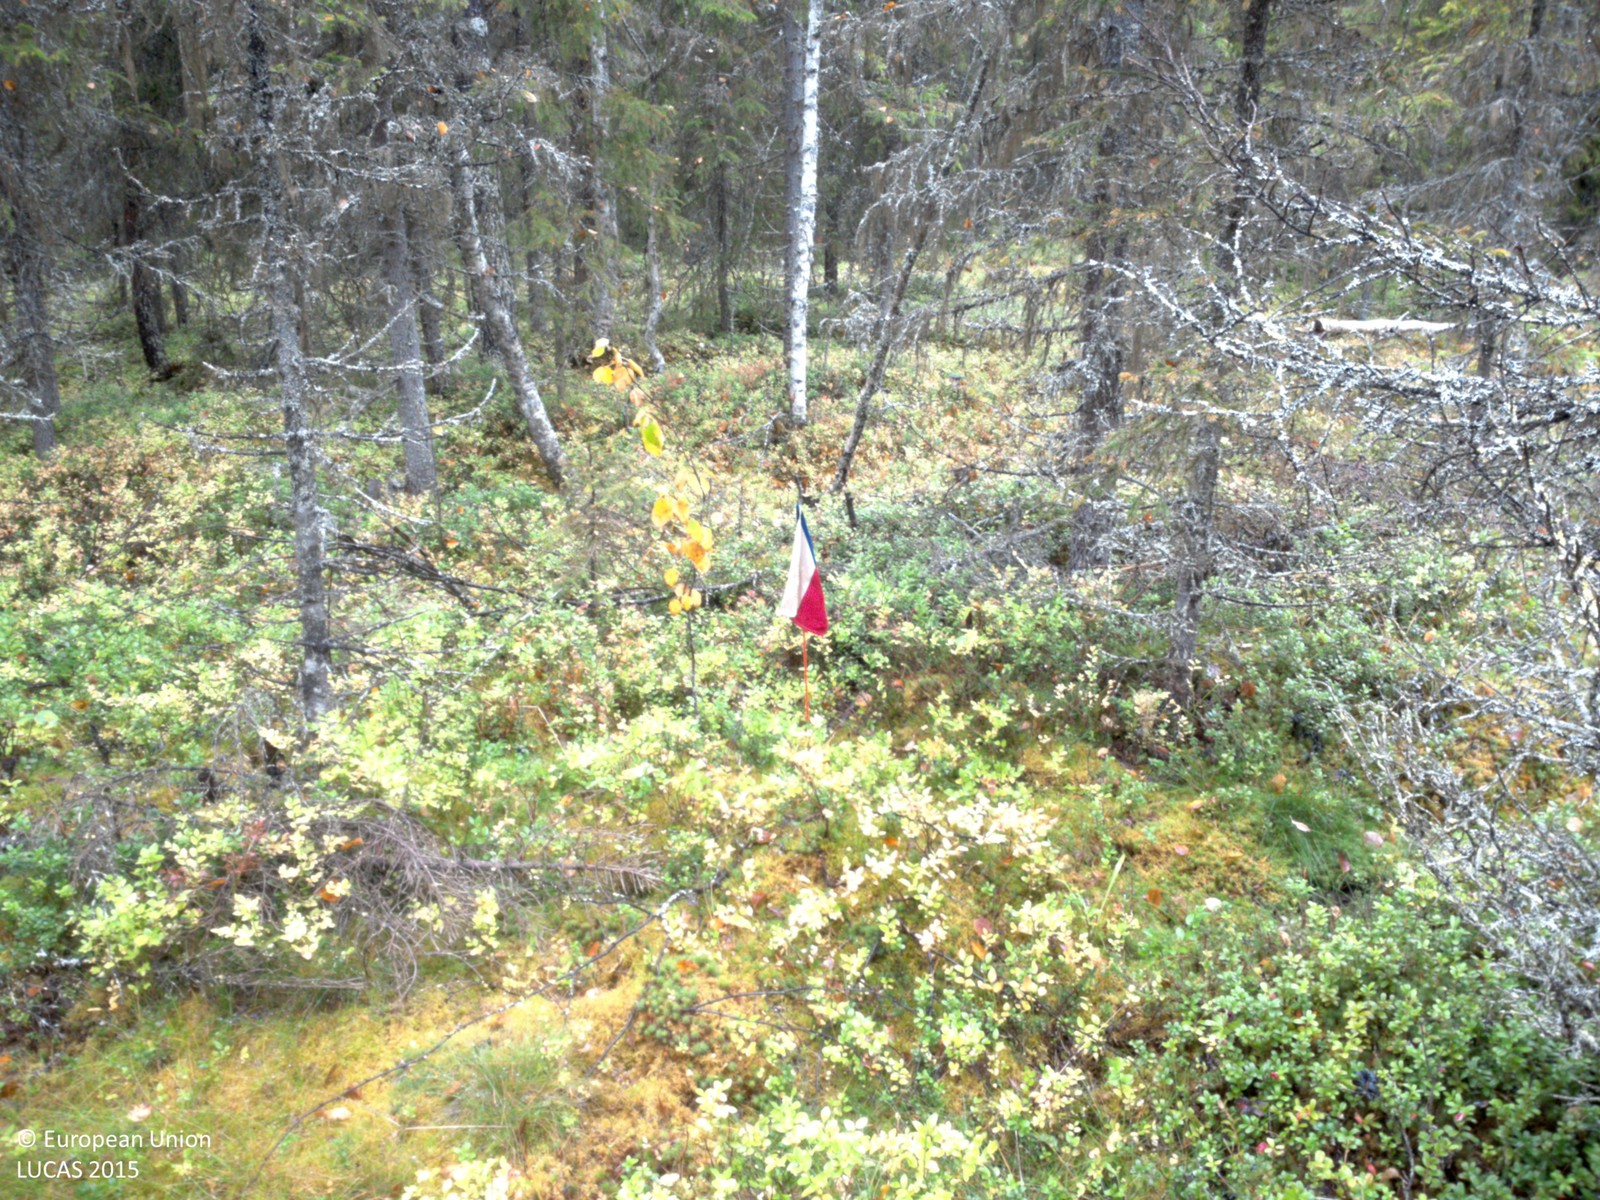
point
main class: Woodland
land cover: Spruce dominated mixed woodland
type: boreal forest
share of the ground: > 75 %
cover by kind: coniferous forest trees 55 %, broadleaved forest trees 25 %, shrubs 10 %, herbaceous plants 5 %, lichens and mosses 5 %
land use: Forestry
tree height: > 5 m
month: September
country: SE
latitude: 64.9967
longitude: 19.0196
